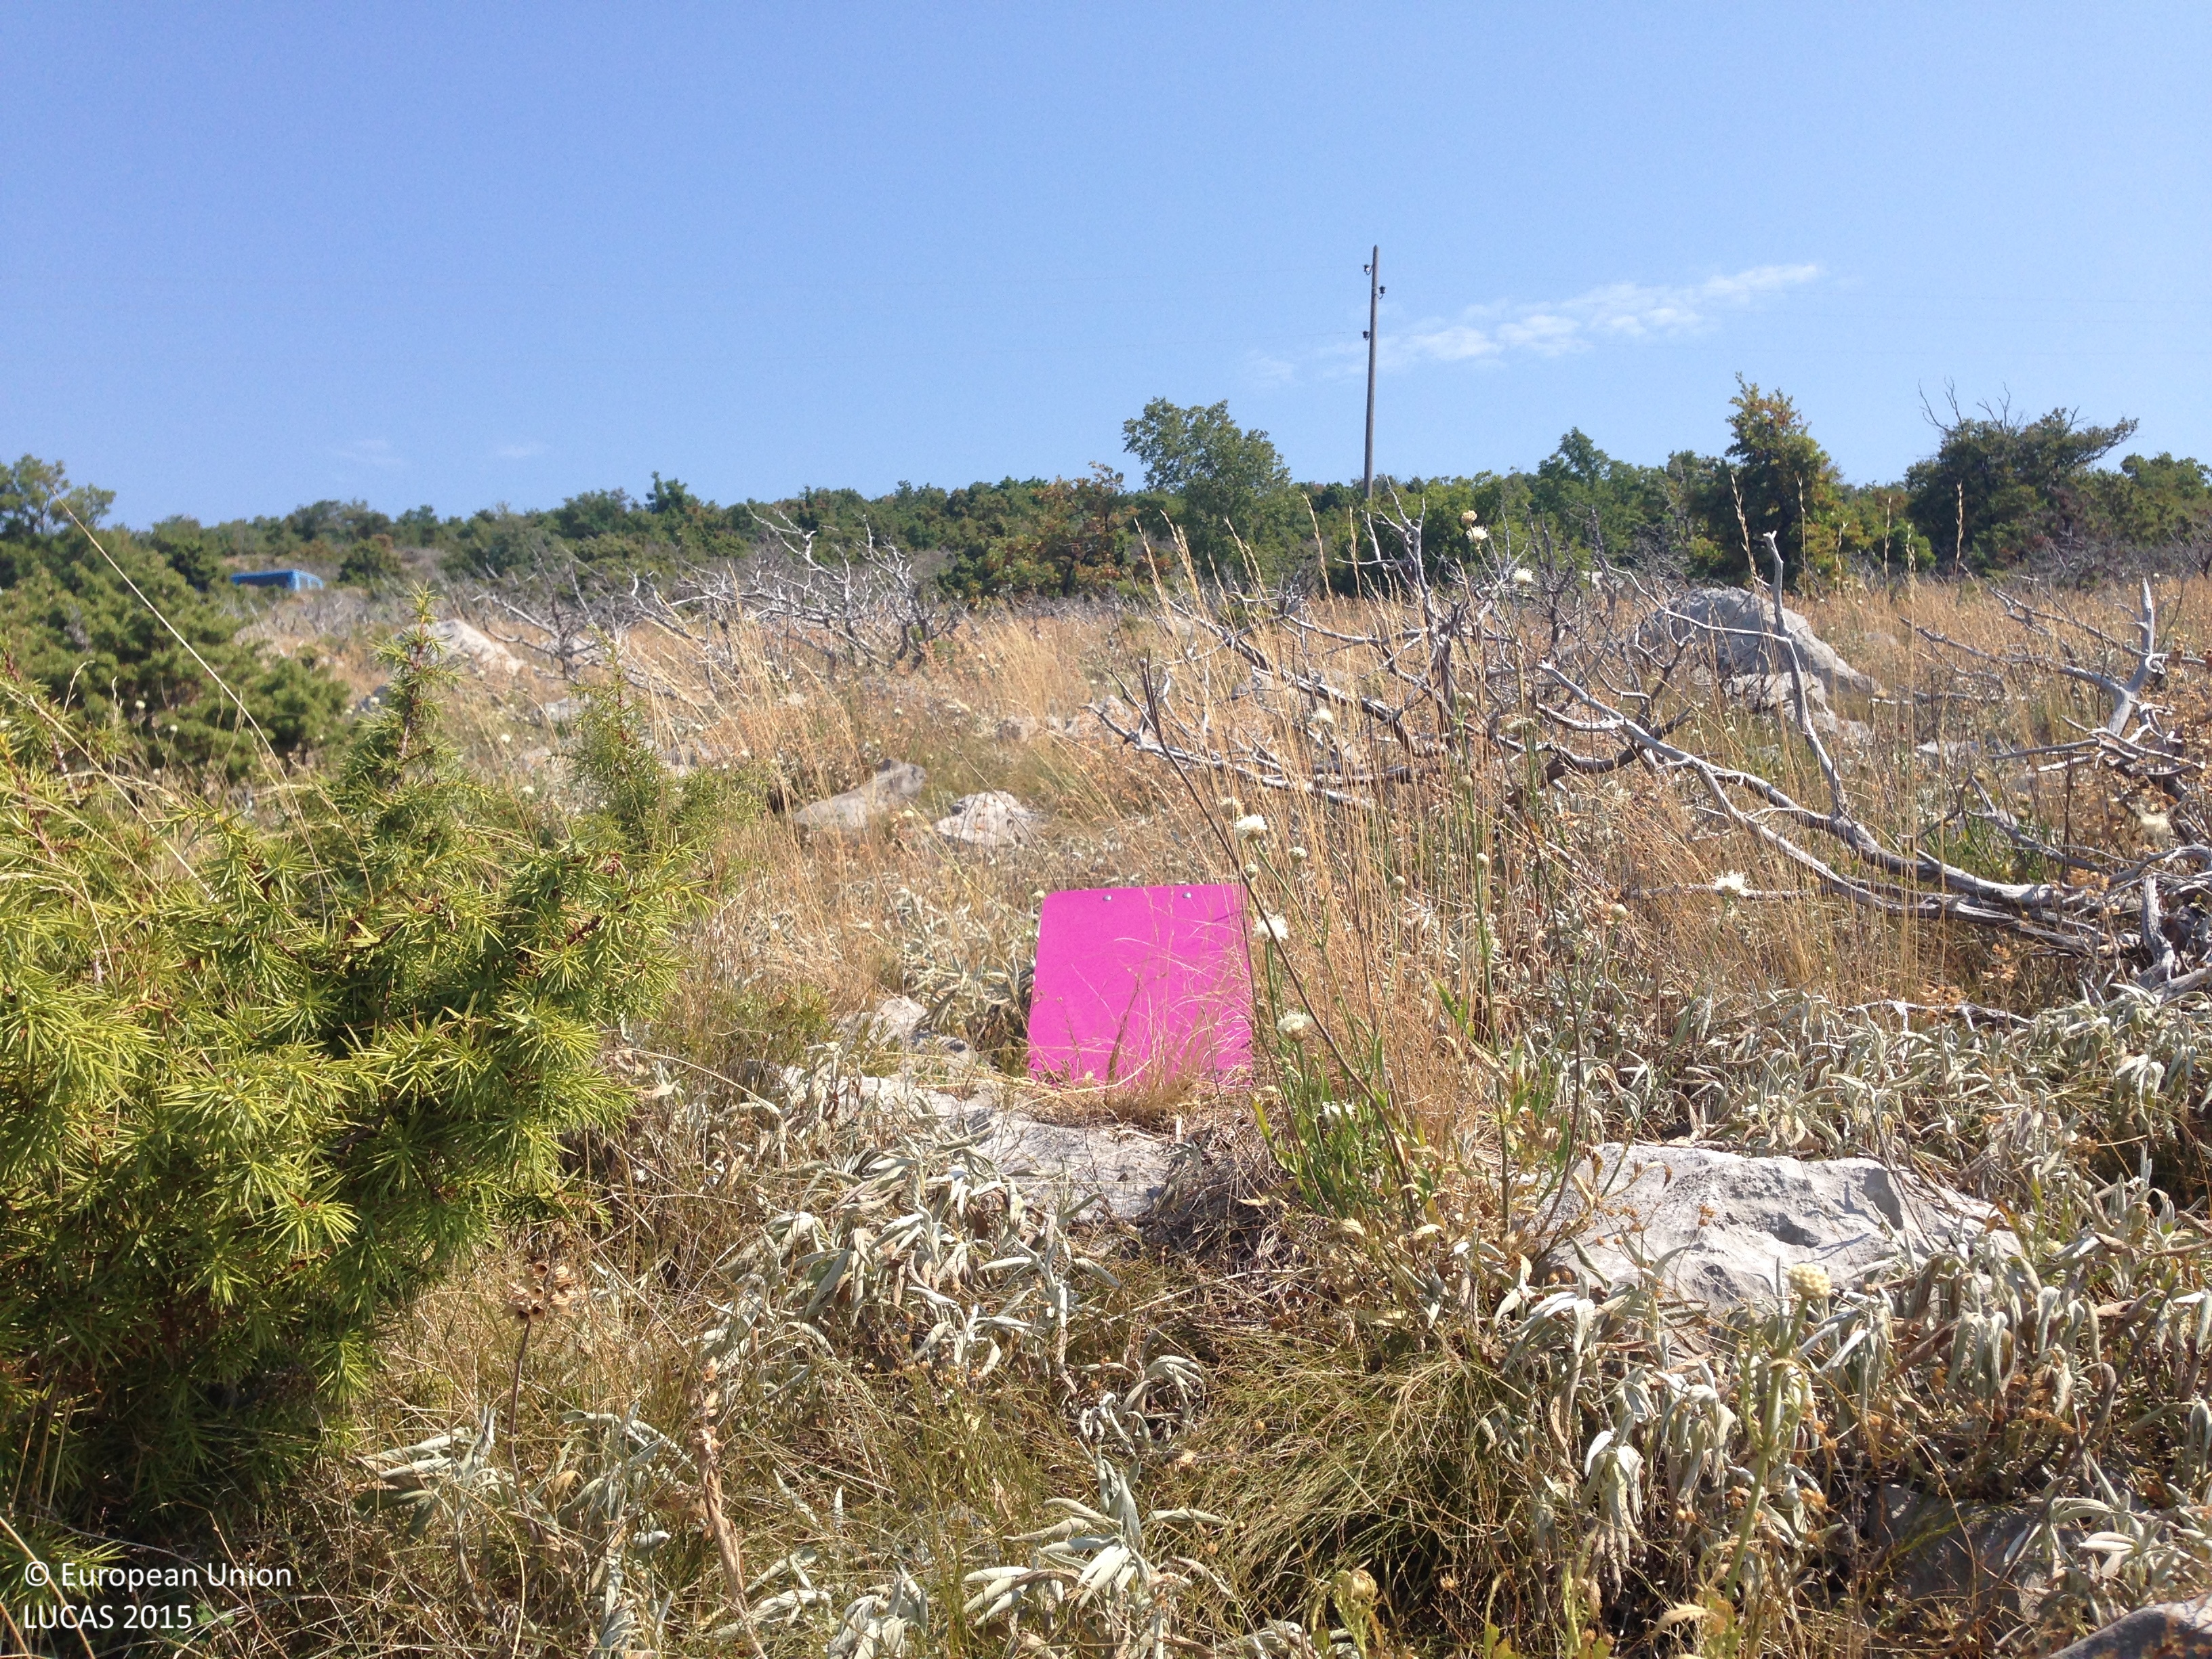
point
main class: Shrubland
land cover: Shrubland with sparse tree cover
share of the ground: 25 - 50 %
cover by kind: shrubs 40 %, herbaceous plants 25 %, unconsolidated bare surface 20 %, consolidated bare surface 10 %, broadleaved forest trees 5 %
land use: Semi-natural and natural areas not in use
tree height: < 5 m
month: July
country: HR
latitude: 44.9370
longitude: 14.9489
